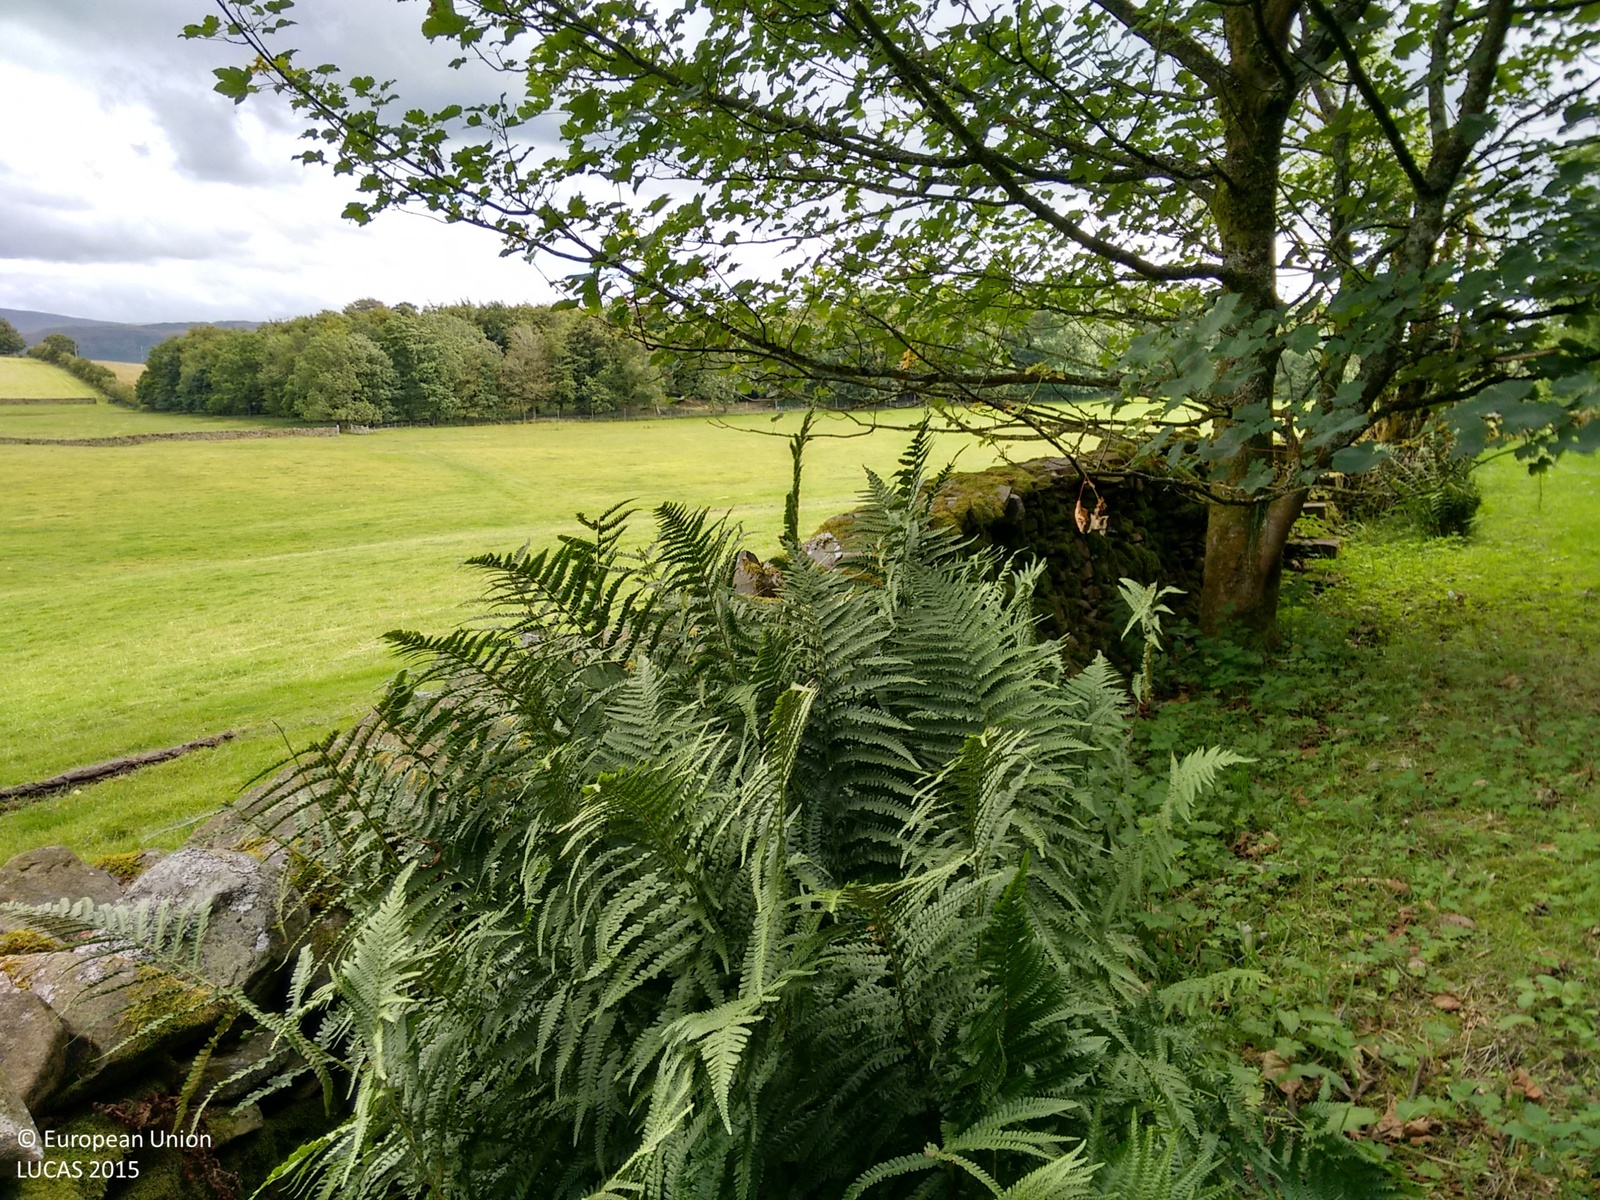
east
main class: Grassland
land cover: Grassland without tree/shrub cover
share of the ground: > 75 %
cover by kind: herbaceous plants 100 %
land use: Agriculture (excluding fallow land and kitchen gardens)
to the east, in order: Grassland without tree/shrub cover; Dry stone walls; Grassland without tree/shrub cover
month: August
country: GB
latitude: 54.2305
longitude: -2.6305
